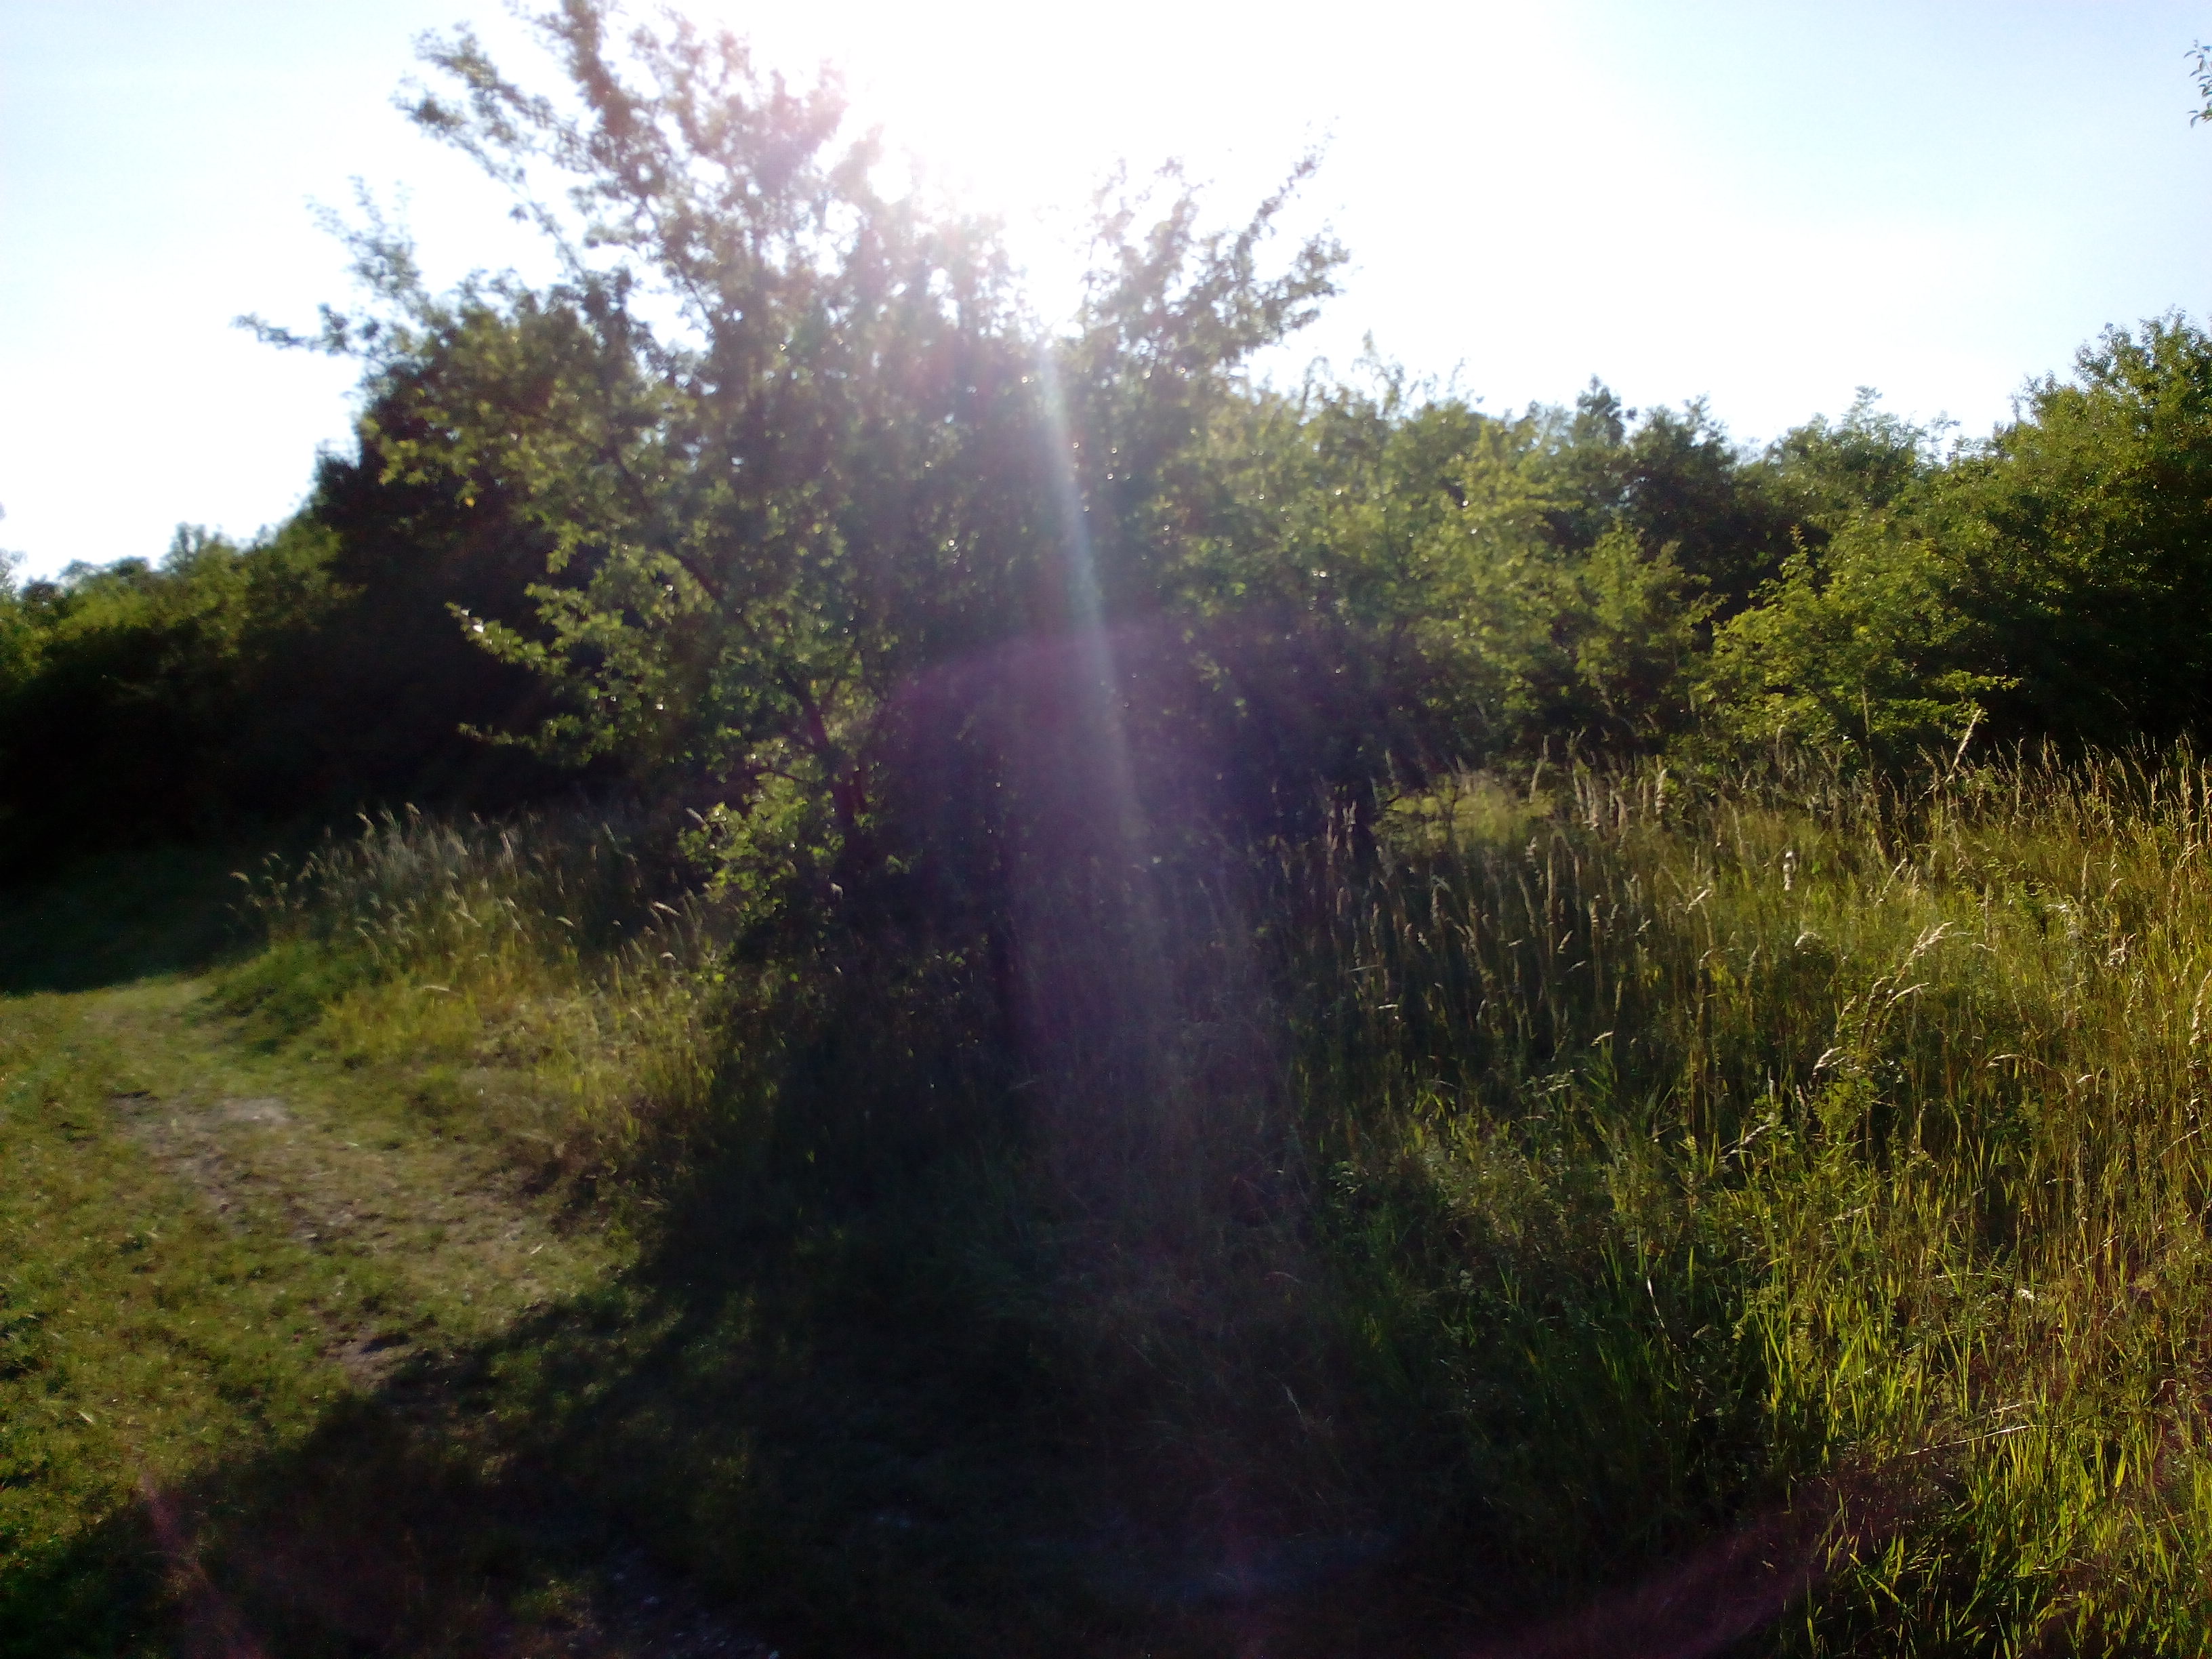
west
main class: Woodland
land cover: Broadleaved woodland
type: mesophytic deciduous forest
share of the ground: 50 - 75 %
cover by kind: broadleaved forest trees 70 %, shrubs 30 %
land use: Abandoned areas
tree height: > 5 m
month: July
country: DE
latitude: 51.1512
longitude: 10.9576
